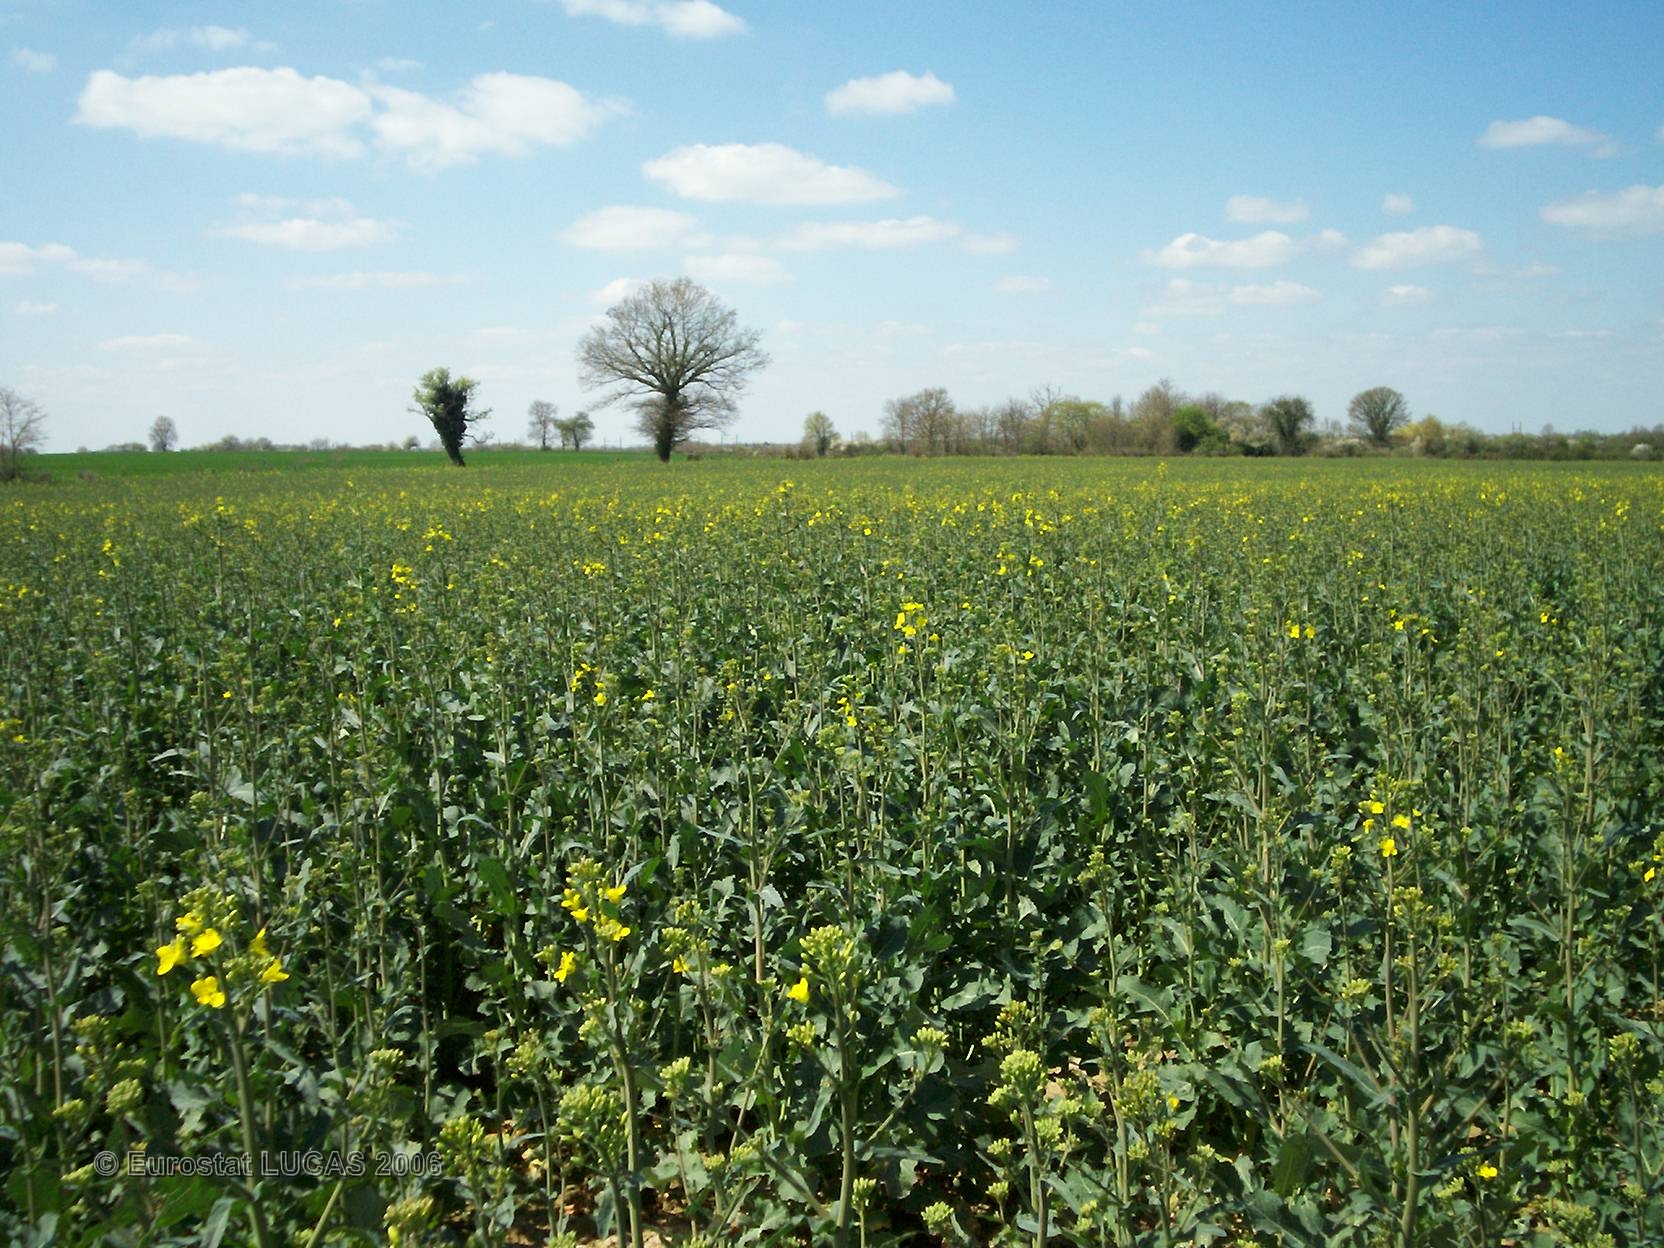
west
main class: Cropland
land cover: Rape and turnip rape
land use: Agriculture (excluding fallow land and kitchen gardens)
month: April
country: FR
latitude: 46.7066
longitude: 1.5791
